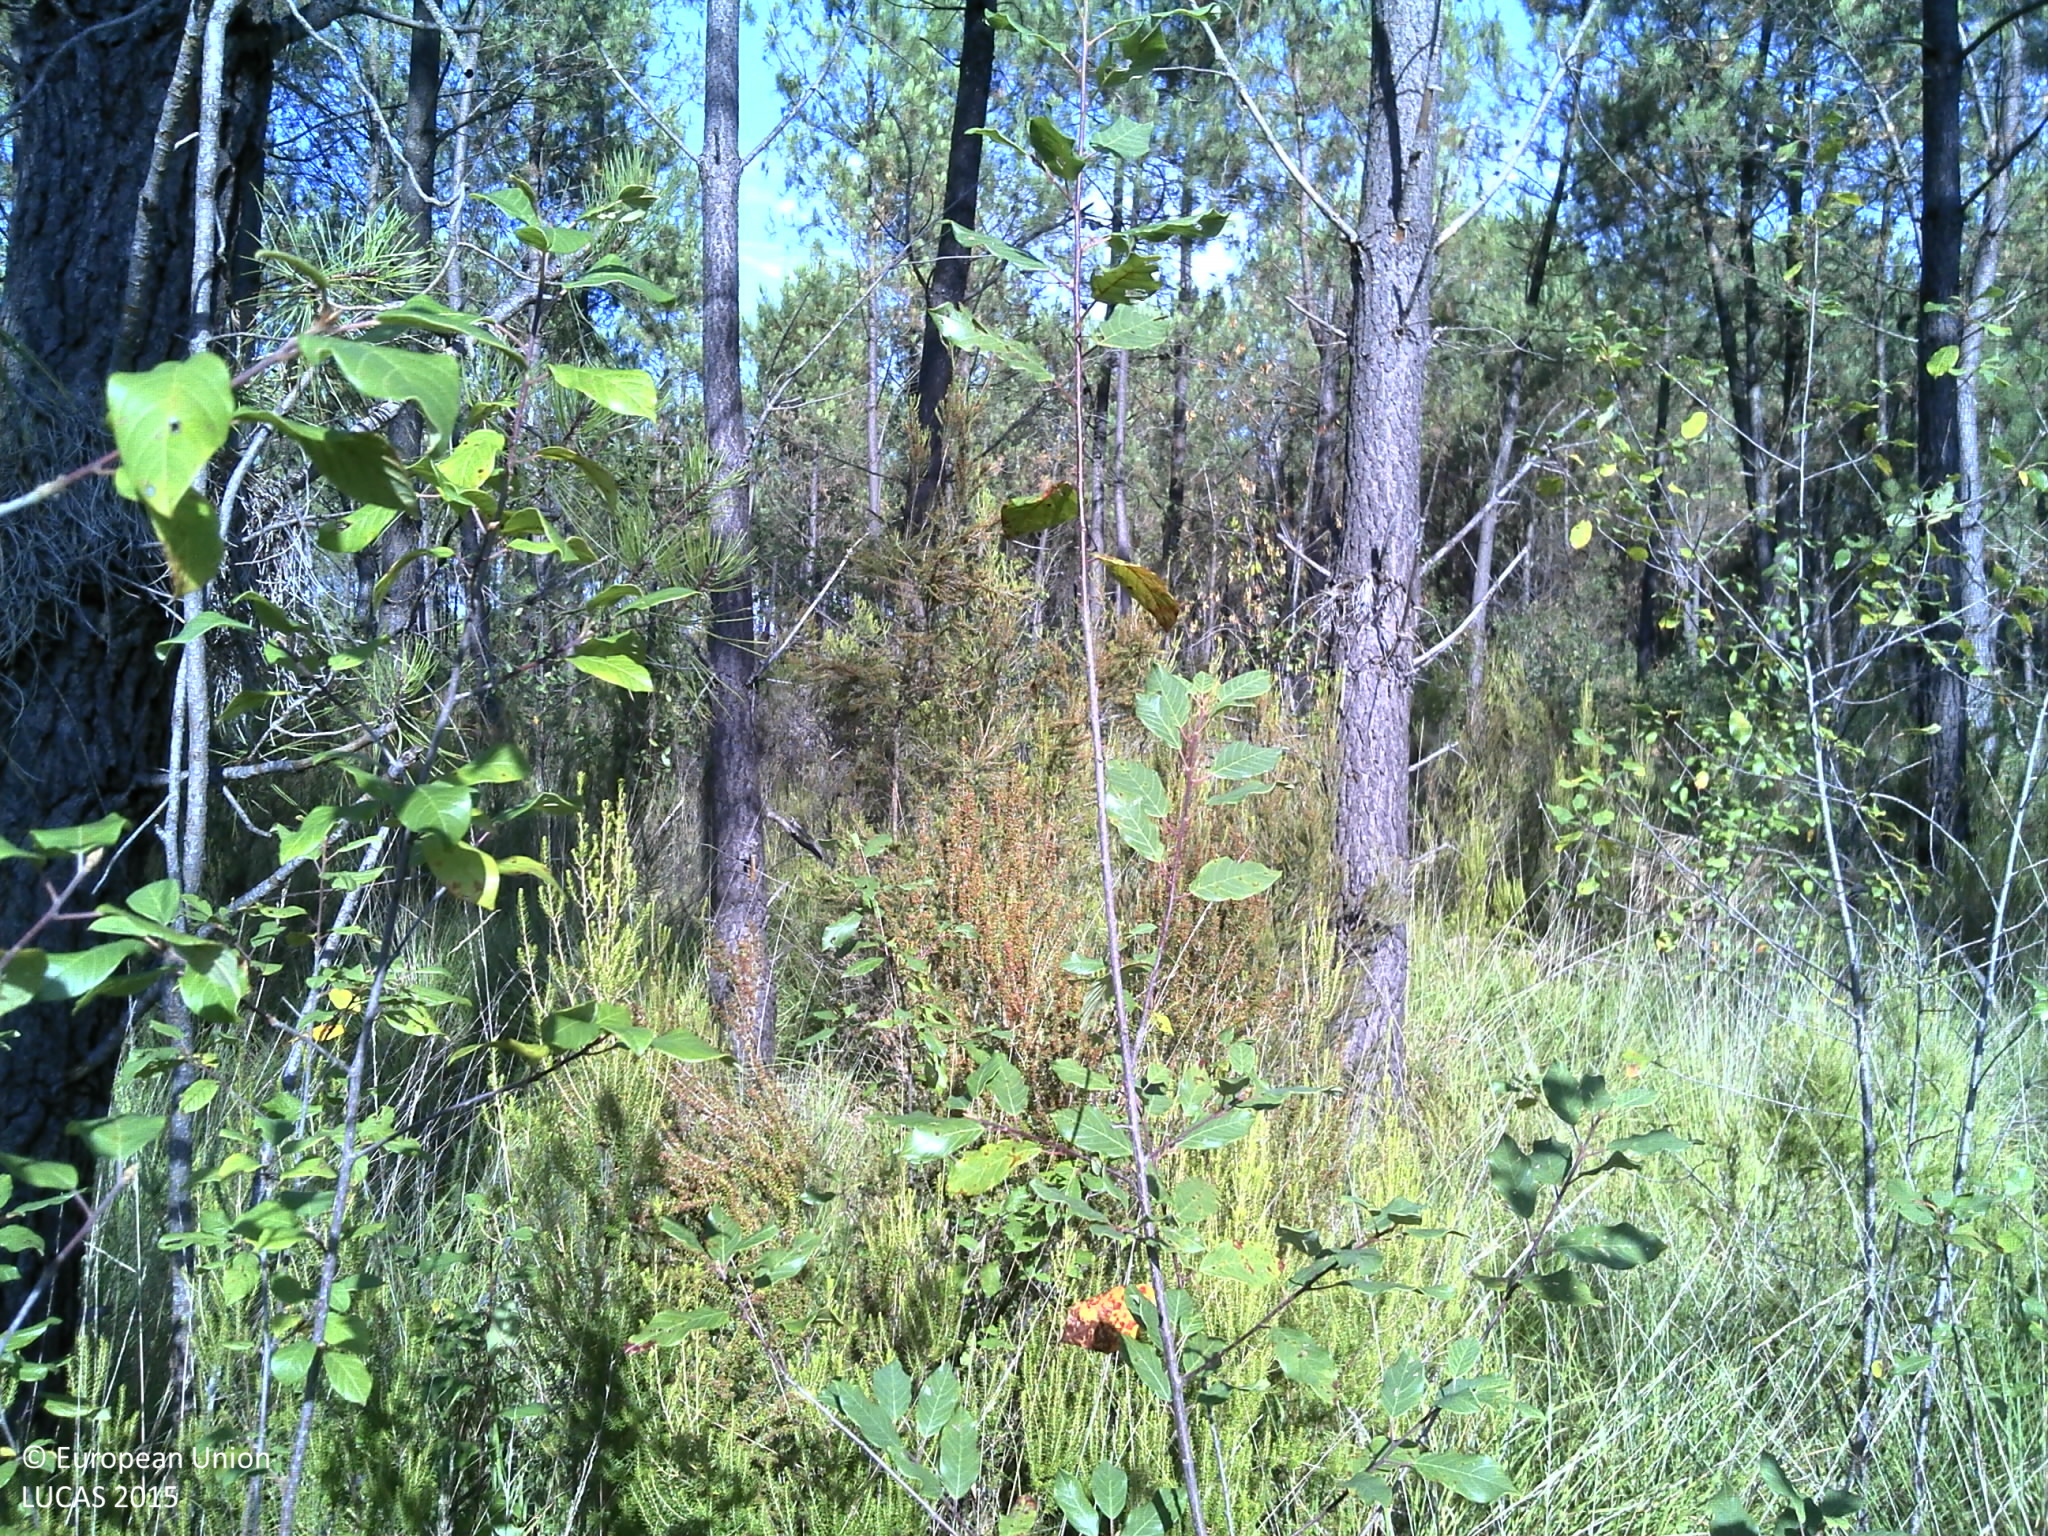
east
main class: Woodland
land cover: Pine dominated coniferous woodland
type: coniferous forest of the mediterranean region
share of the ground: > 75 %
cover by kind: coniferous forest trees 60 %, shrubs 30 %, herbaceous plants 5 %, lichens and mosses 5 %
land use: Forestry
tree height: > 5 m
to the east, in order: Pine dominated coniferous woodland; Ditches and canals; Pine dominated coniferous woodland; Tracks; Pine dominated coniferous woodland; Shrubland without tree cover
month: July
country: FR
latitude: 44.5357
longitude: -0.5752
